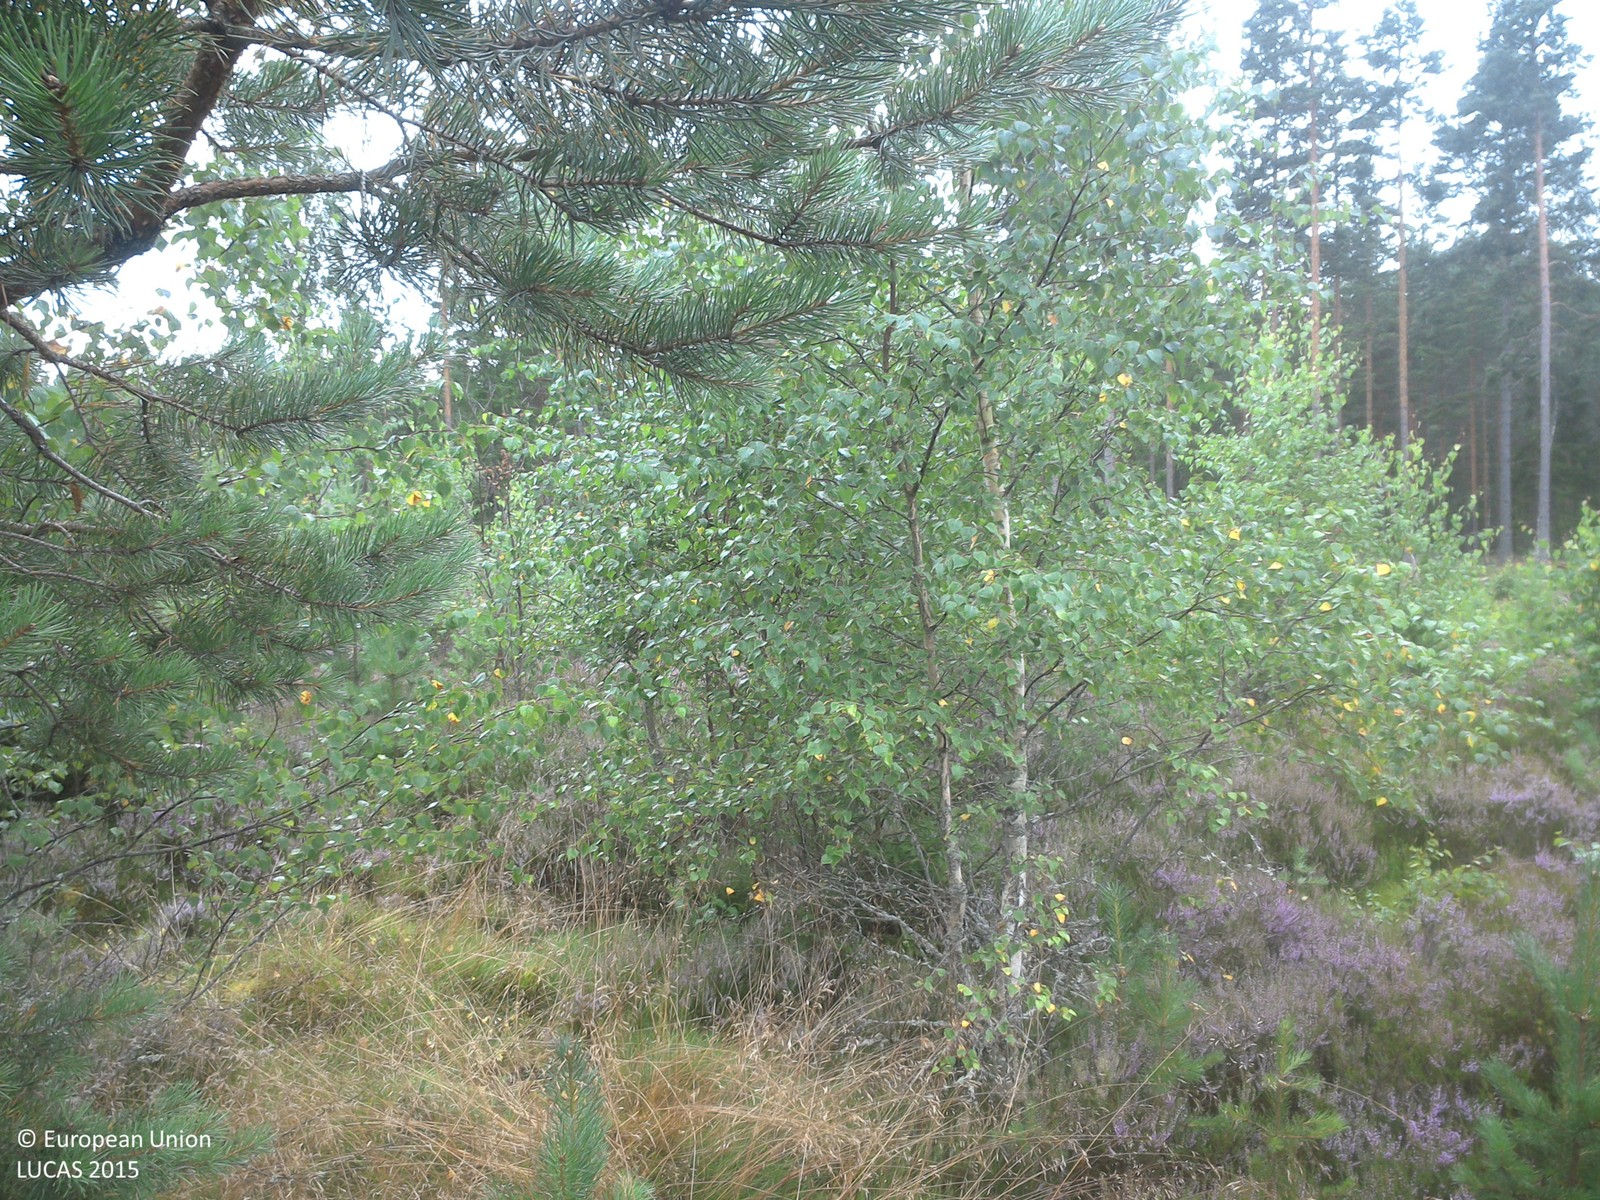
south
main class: Woodland
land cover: Pine dominated mixed woodland
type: boreal forest
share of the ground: 25 - 50 %
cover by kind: herbaceous plants 40 %, coniferous forest trees 25 %, shrubs 20 %, broadleaved forest trees 10 %, lichens and mosses 5 %
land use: Forestry
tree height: < 5 m
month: August
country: SE
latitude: 57.7992
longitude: 15.5316
